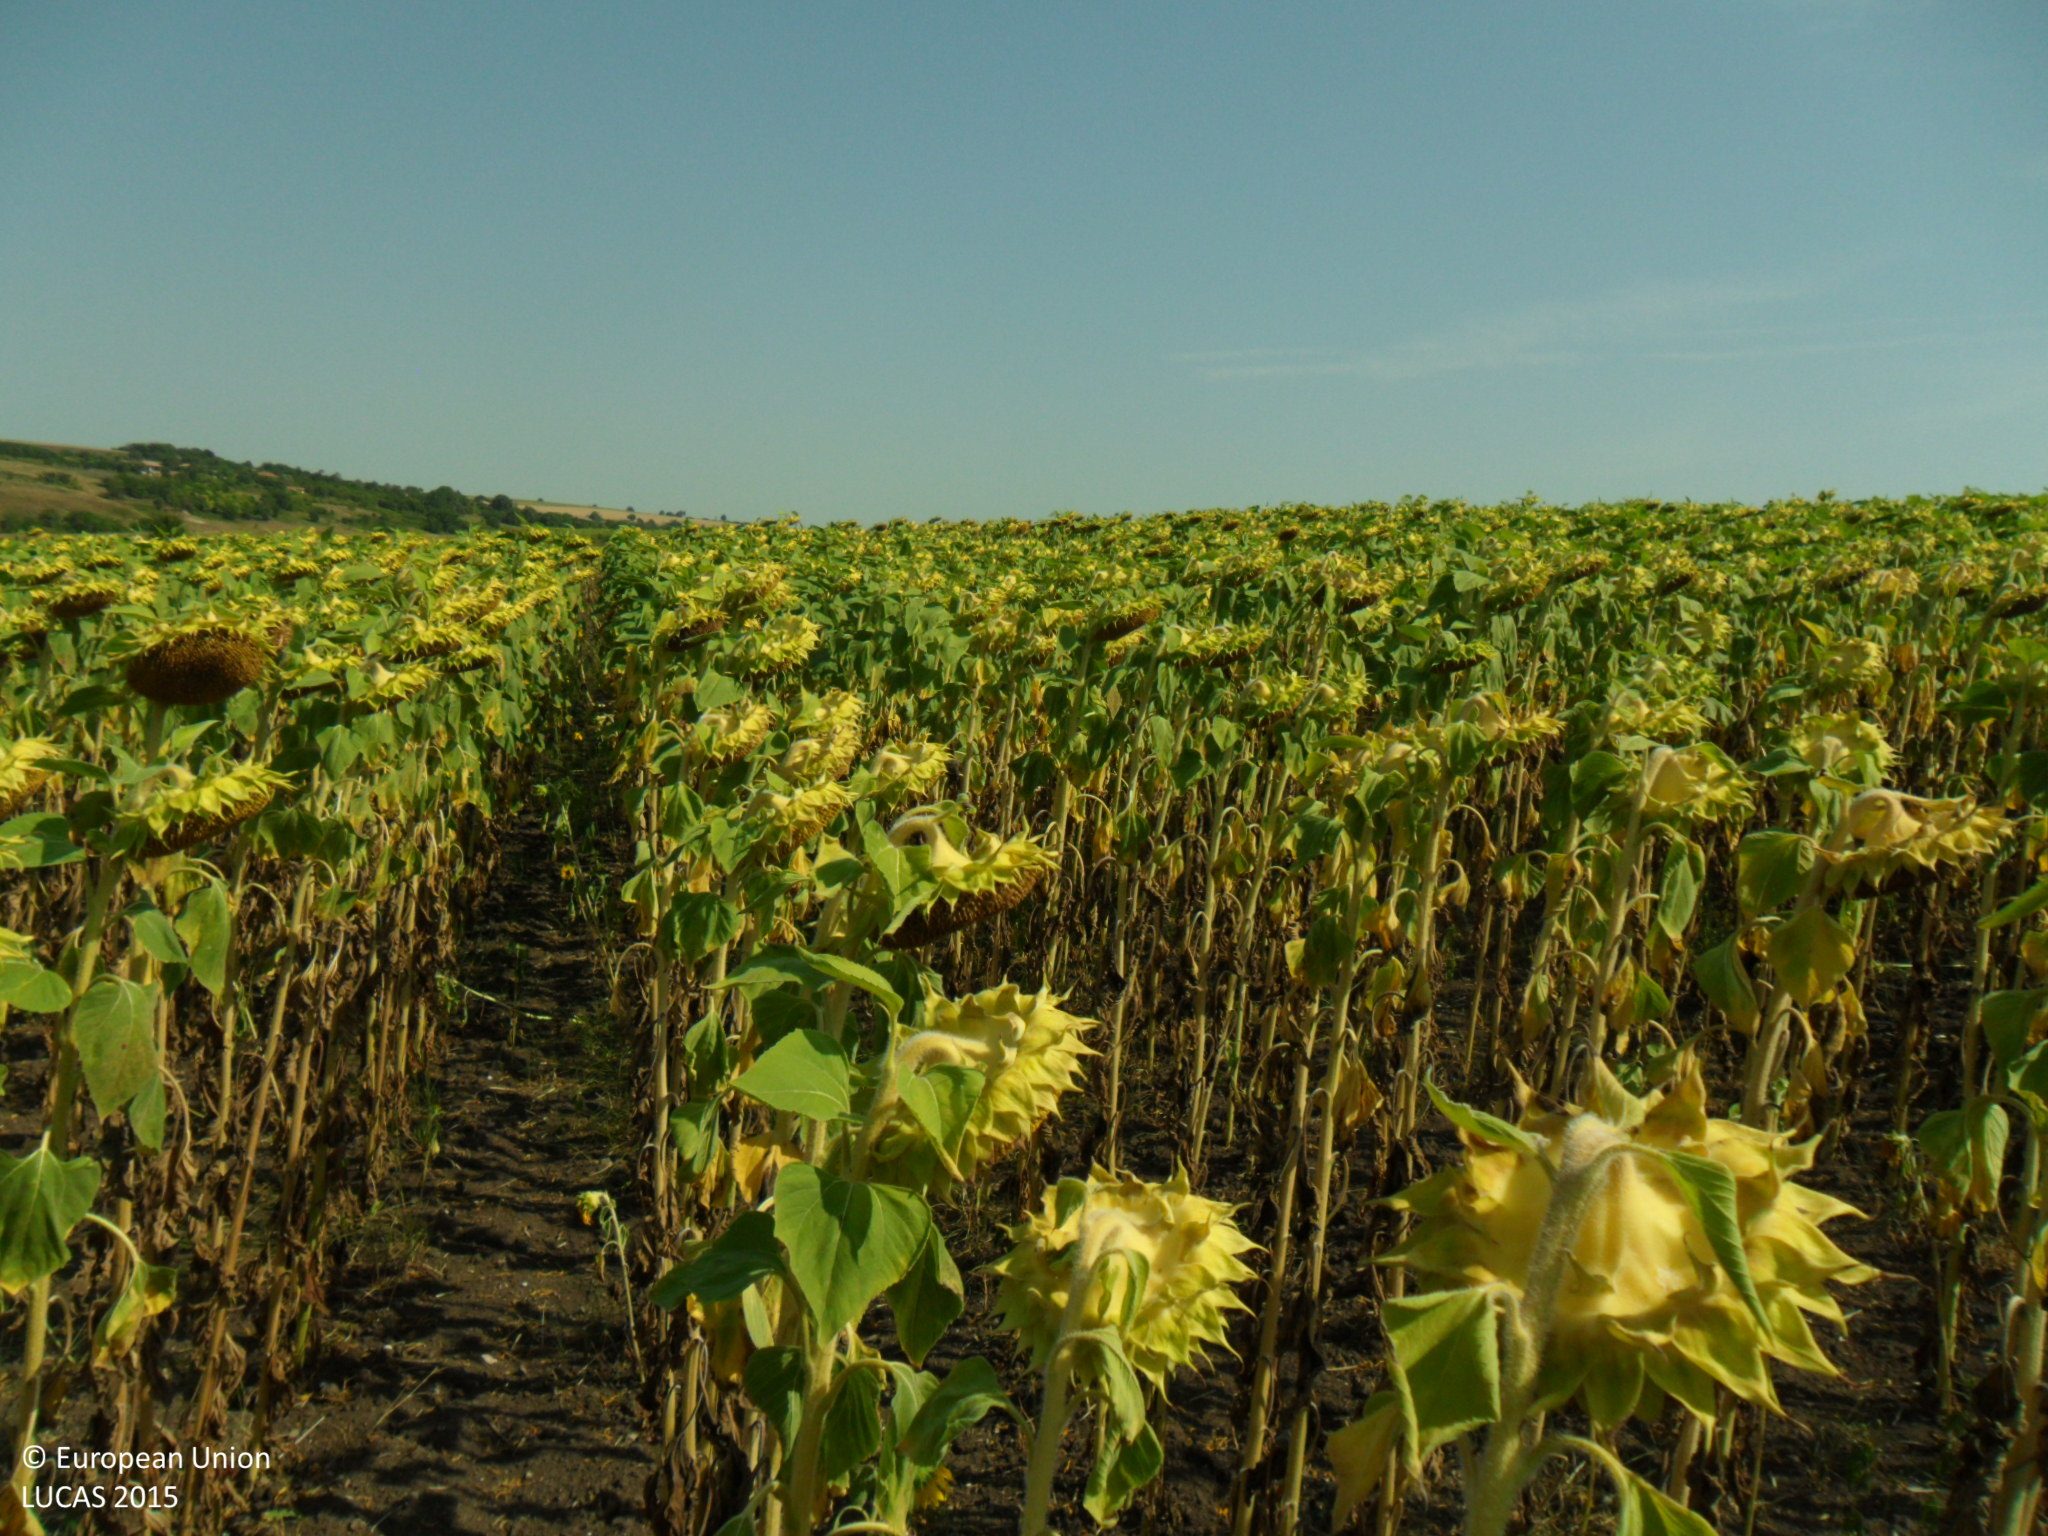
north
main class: Cropland
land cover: Sunflower
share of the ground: > 75 %
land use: Agriculture (excluding fallow land and kitchen gardens)
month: August
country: BG
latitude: 43.3856
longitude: 26.8382
